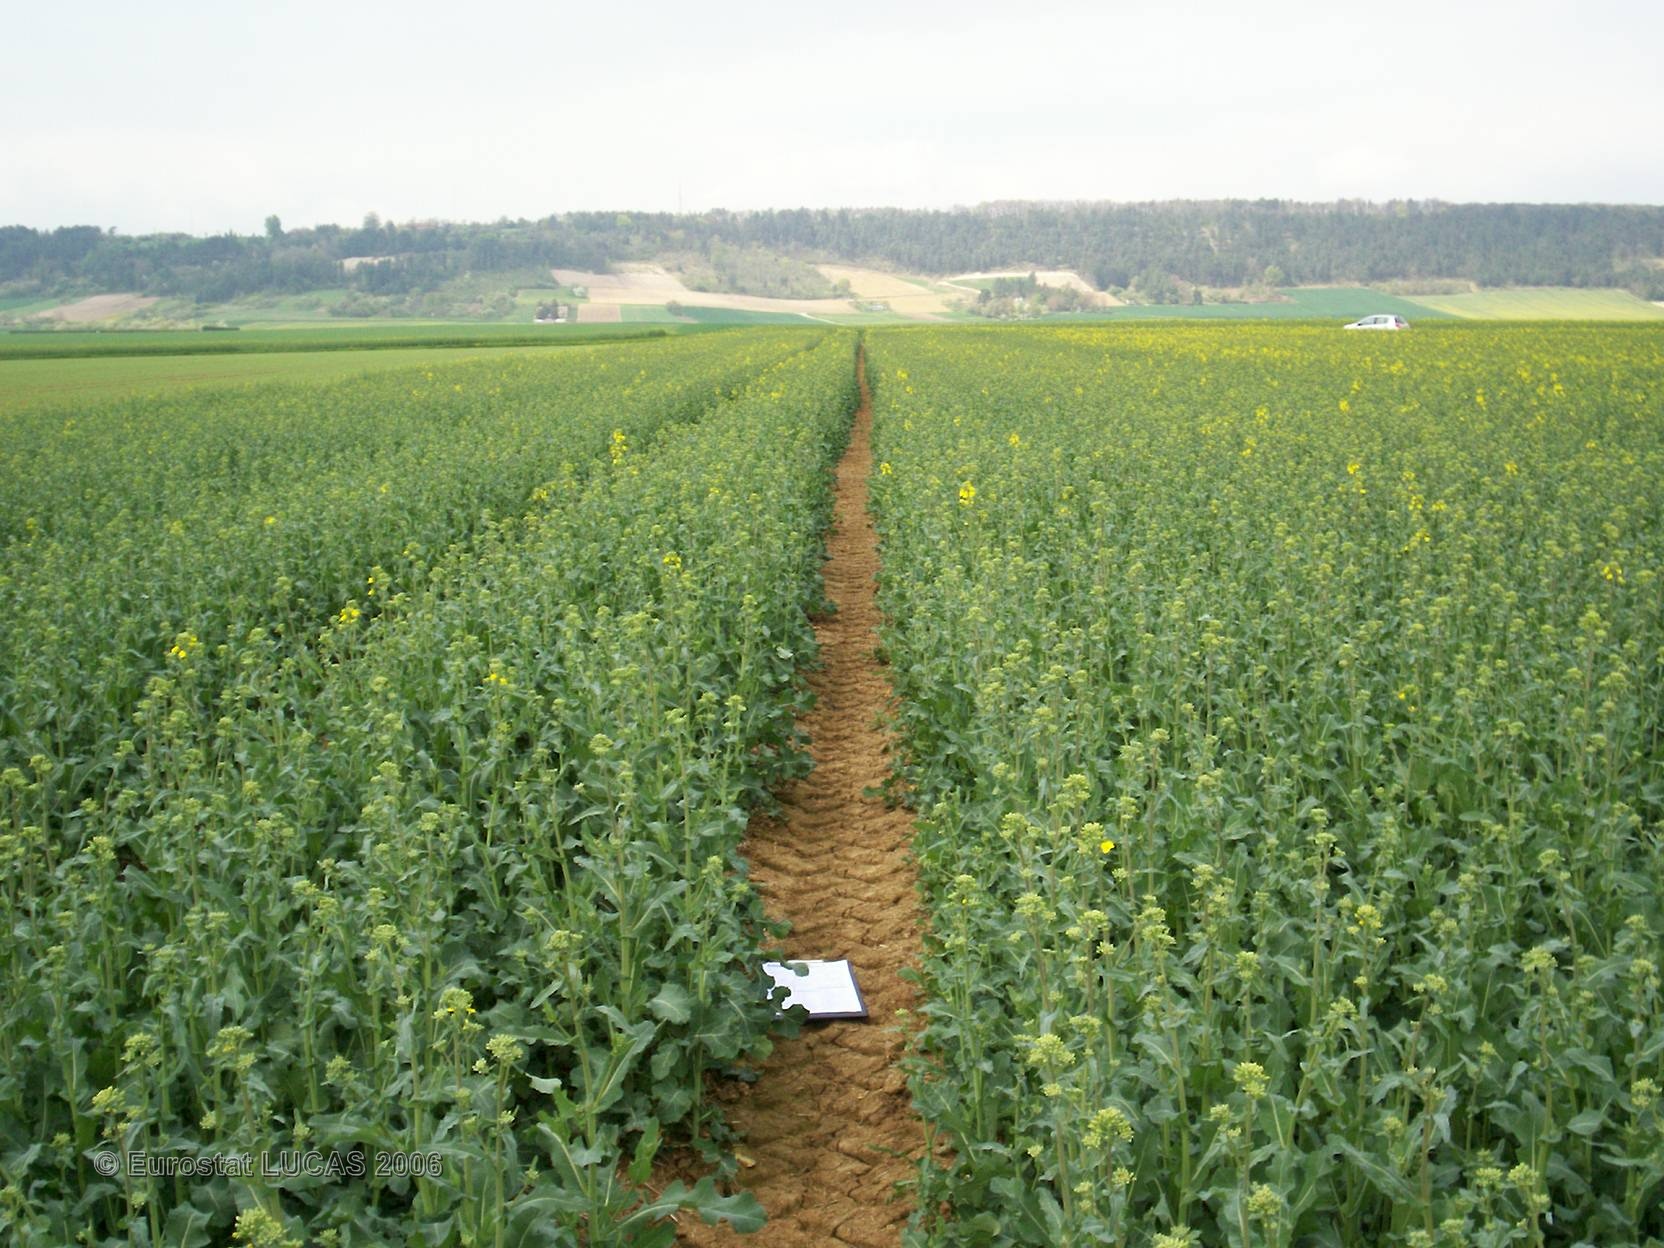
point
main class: Cropland
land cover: Rape and turnip rape
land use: Agriculture (excluding fallow land and kitchen gardens)
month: April
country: FR
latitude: 47.8880
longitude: 4.5017
